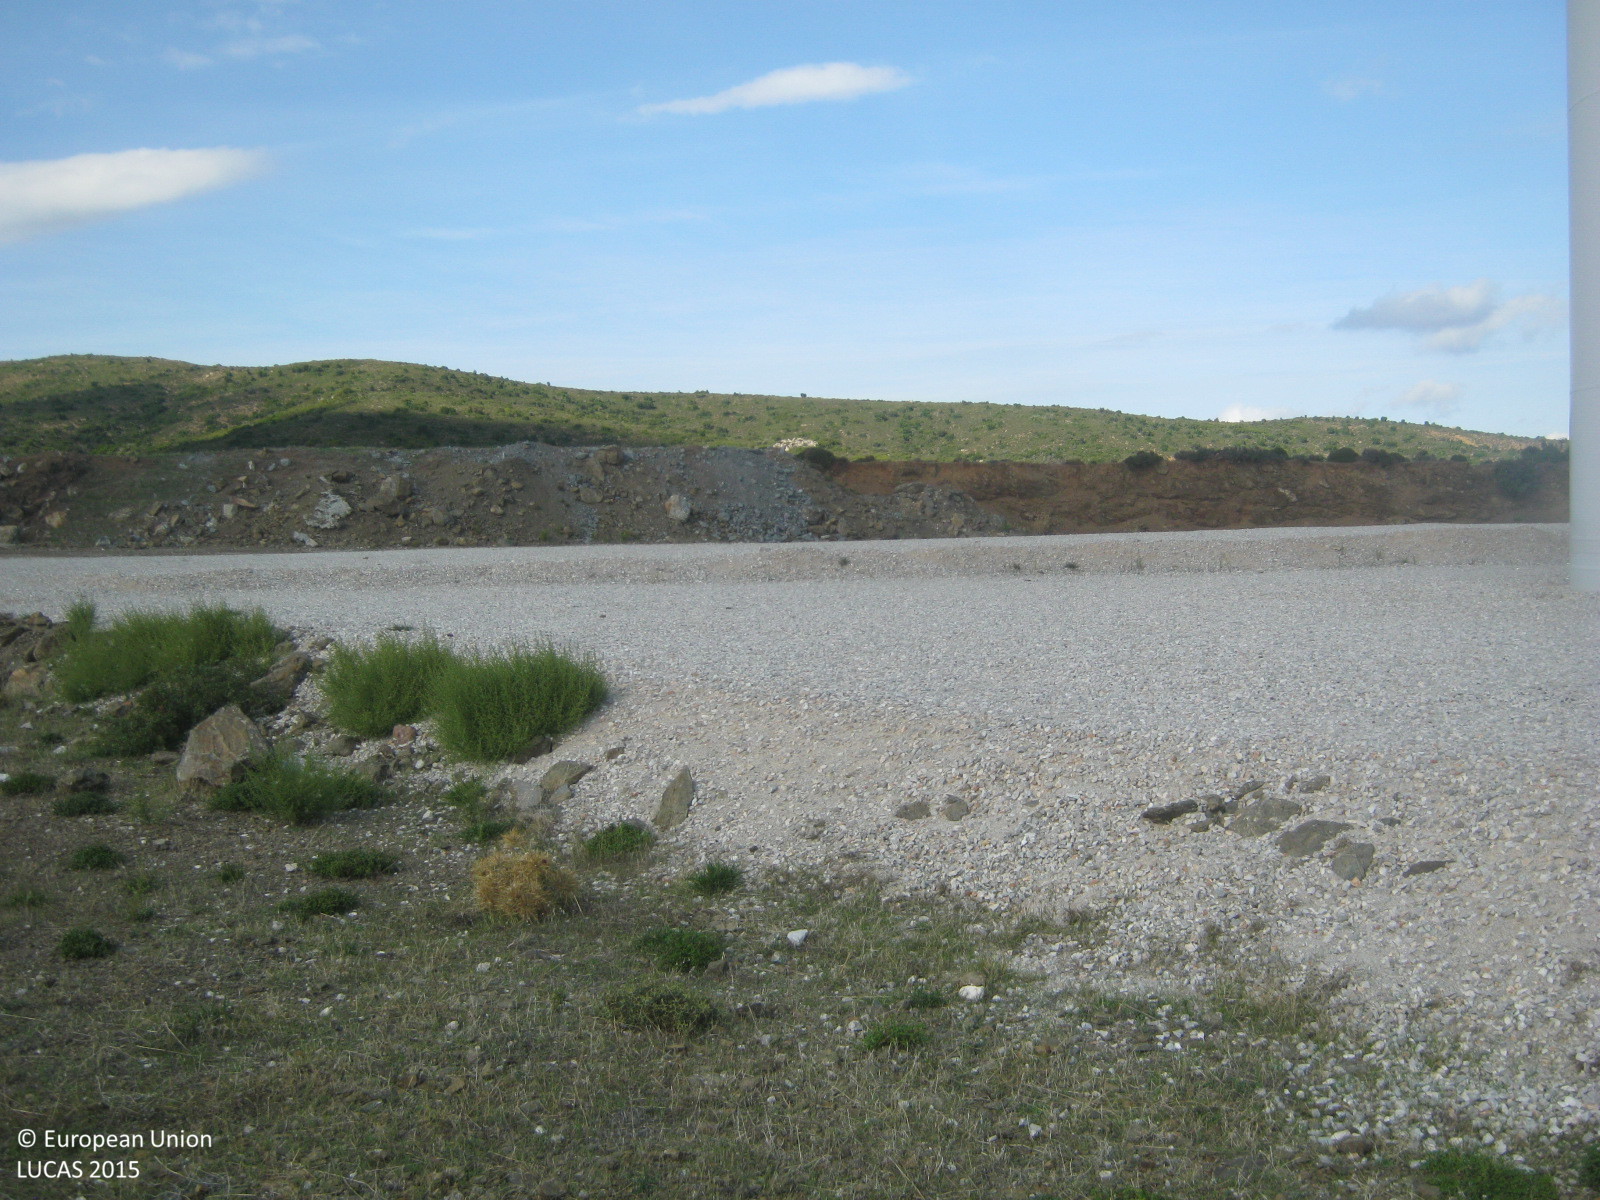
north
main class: Shrubland
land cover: Shrubland without tree cover
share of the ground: > 75 %
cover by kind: shrubs 90 %, unconsolidated bare surface 10 %
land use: Semi-natural and natural areas not in use
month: October
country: GR
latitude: 37.4664
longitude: 23.3216
